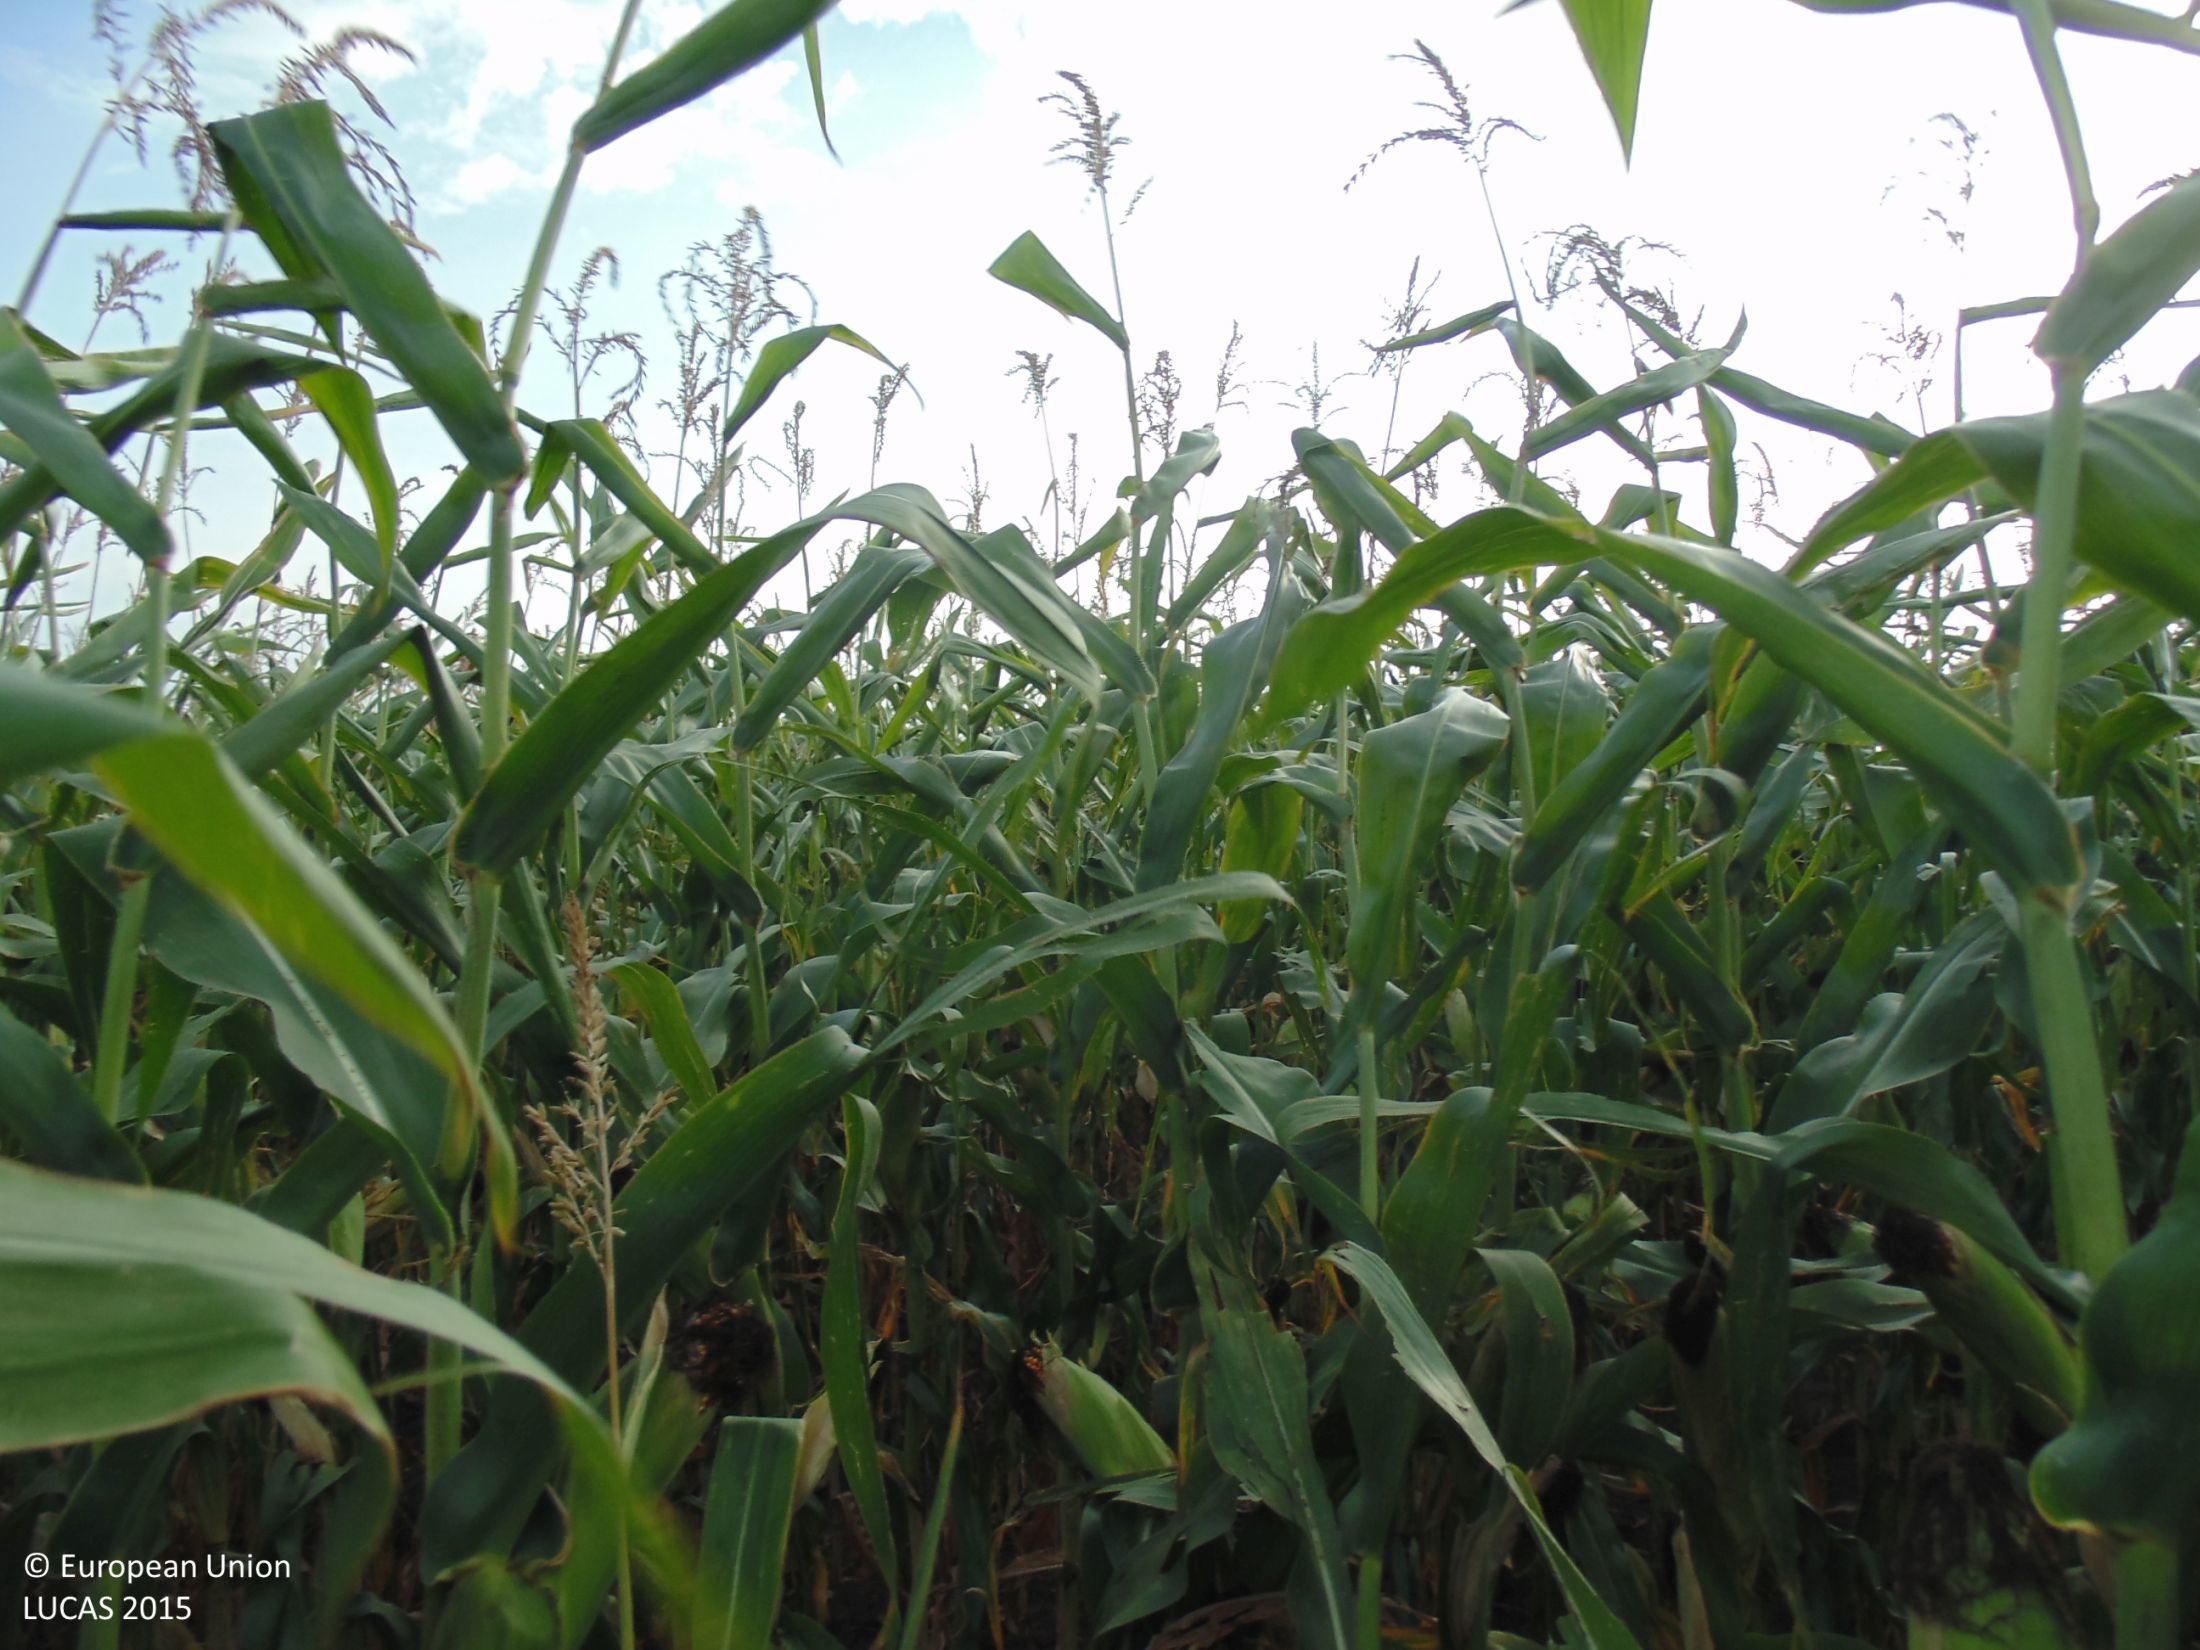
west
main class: Cropland
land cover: Maize
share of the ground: > 75 %
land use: Agriculture (excluding fallow land and kitchen gardens)
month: August
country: BG
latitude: 43.7007
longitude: 28.2091
